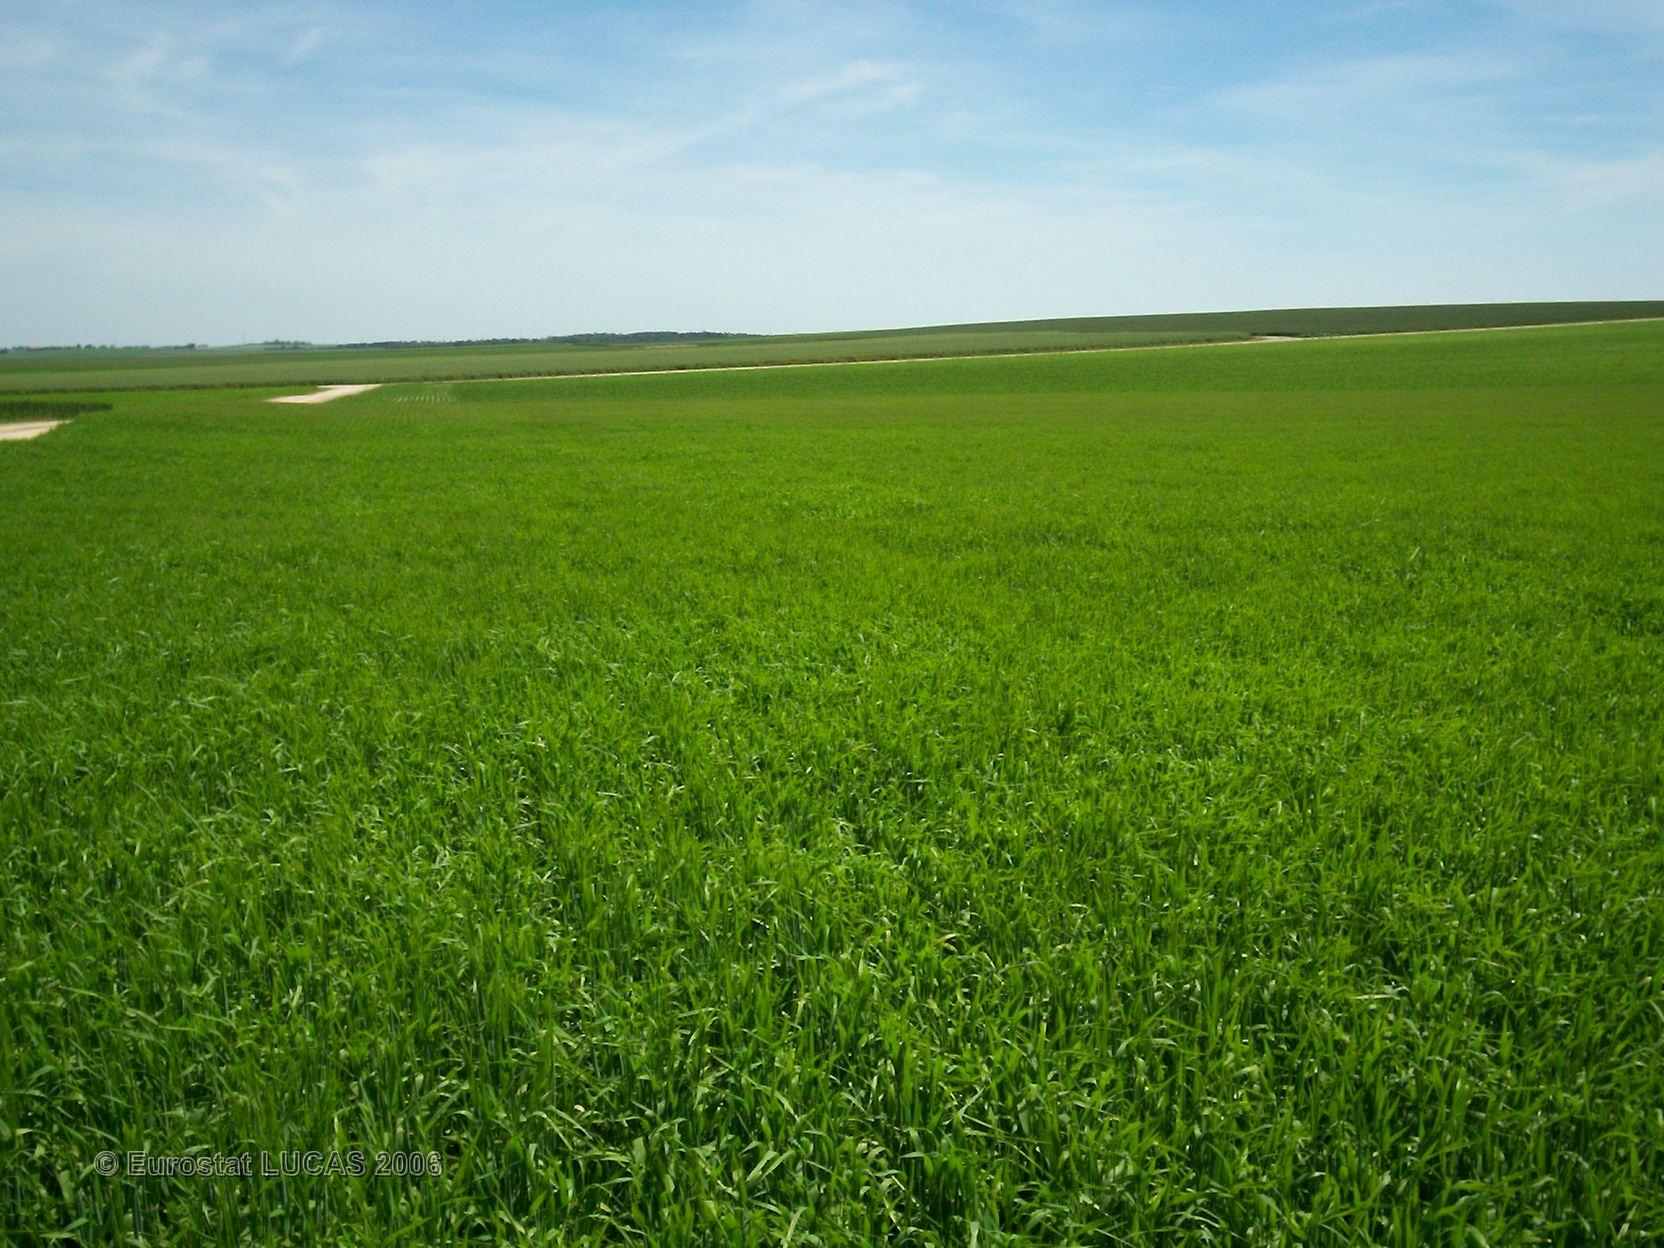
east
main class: Cropland
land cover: Barley
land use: Agriculture (excluding fallow land and kitchen gardens)
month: June
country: FR
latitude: 49.0465
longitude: 4.5926
